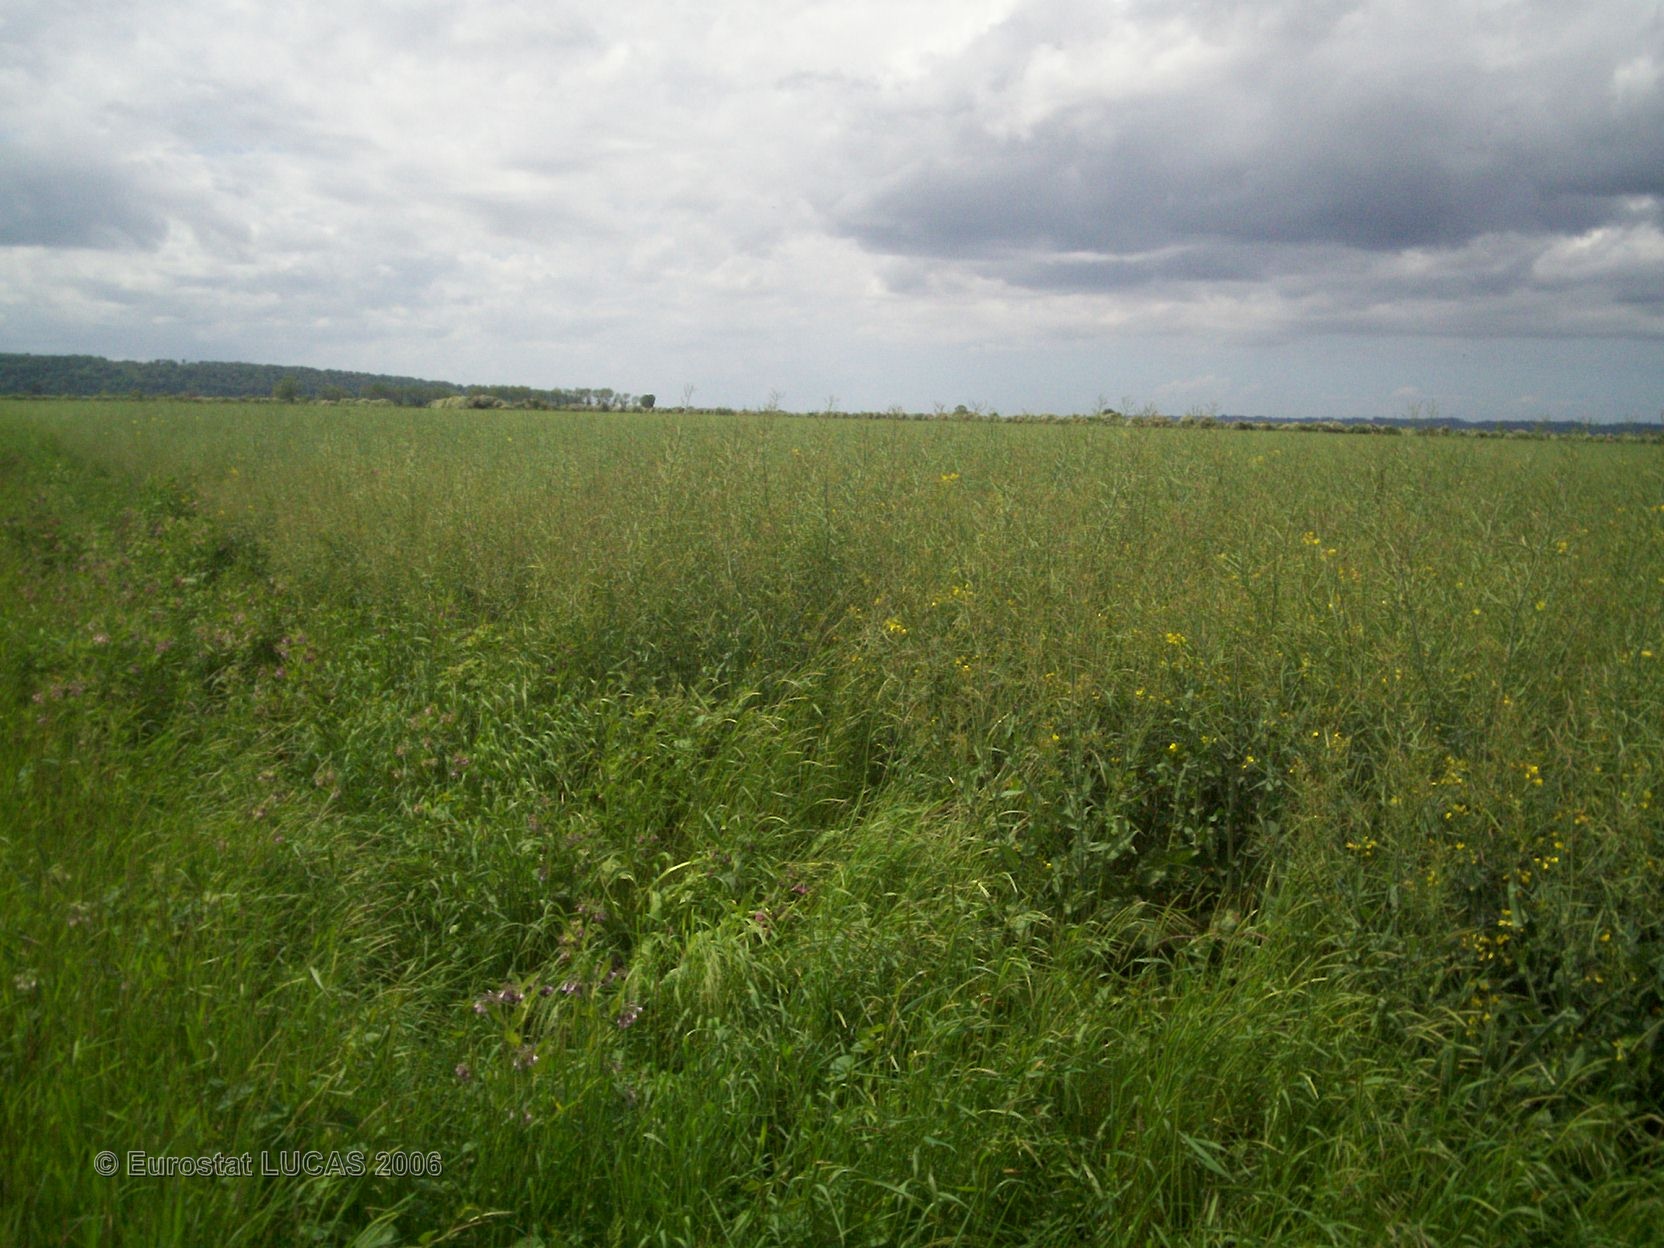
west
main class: Cropland
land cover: Rape and turnip rape
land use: Agriculture (excluding fallow land and kitchen gardens)
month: May
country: FR
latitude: 49.4425
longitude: 0.4984
